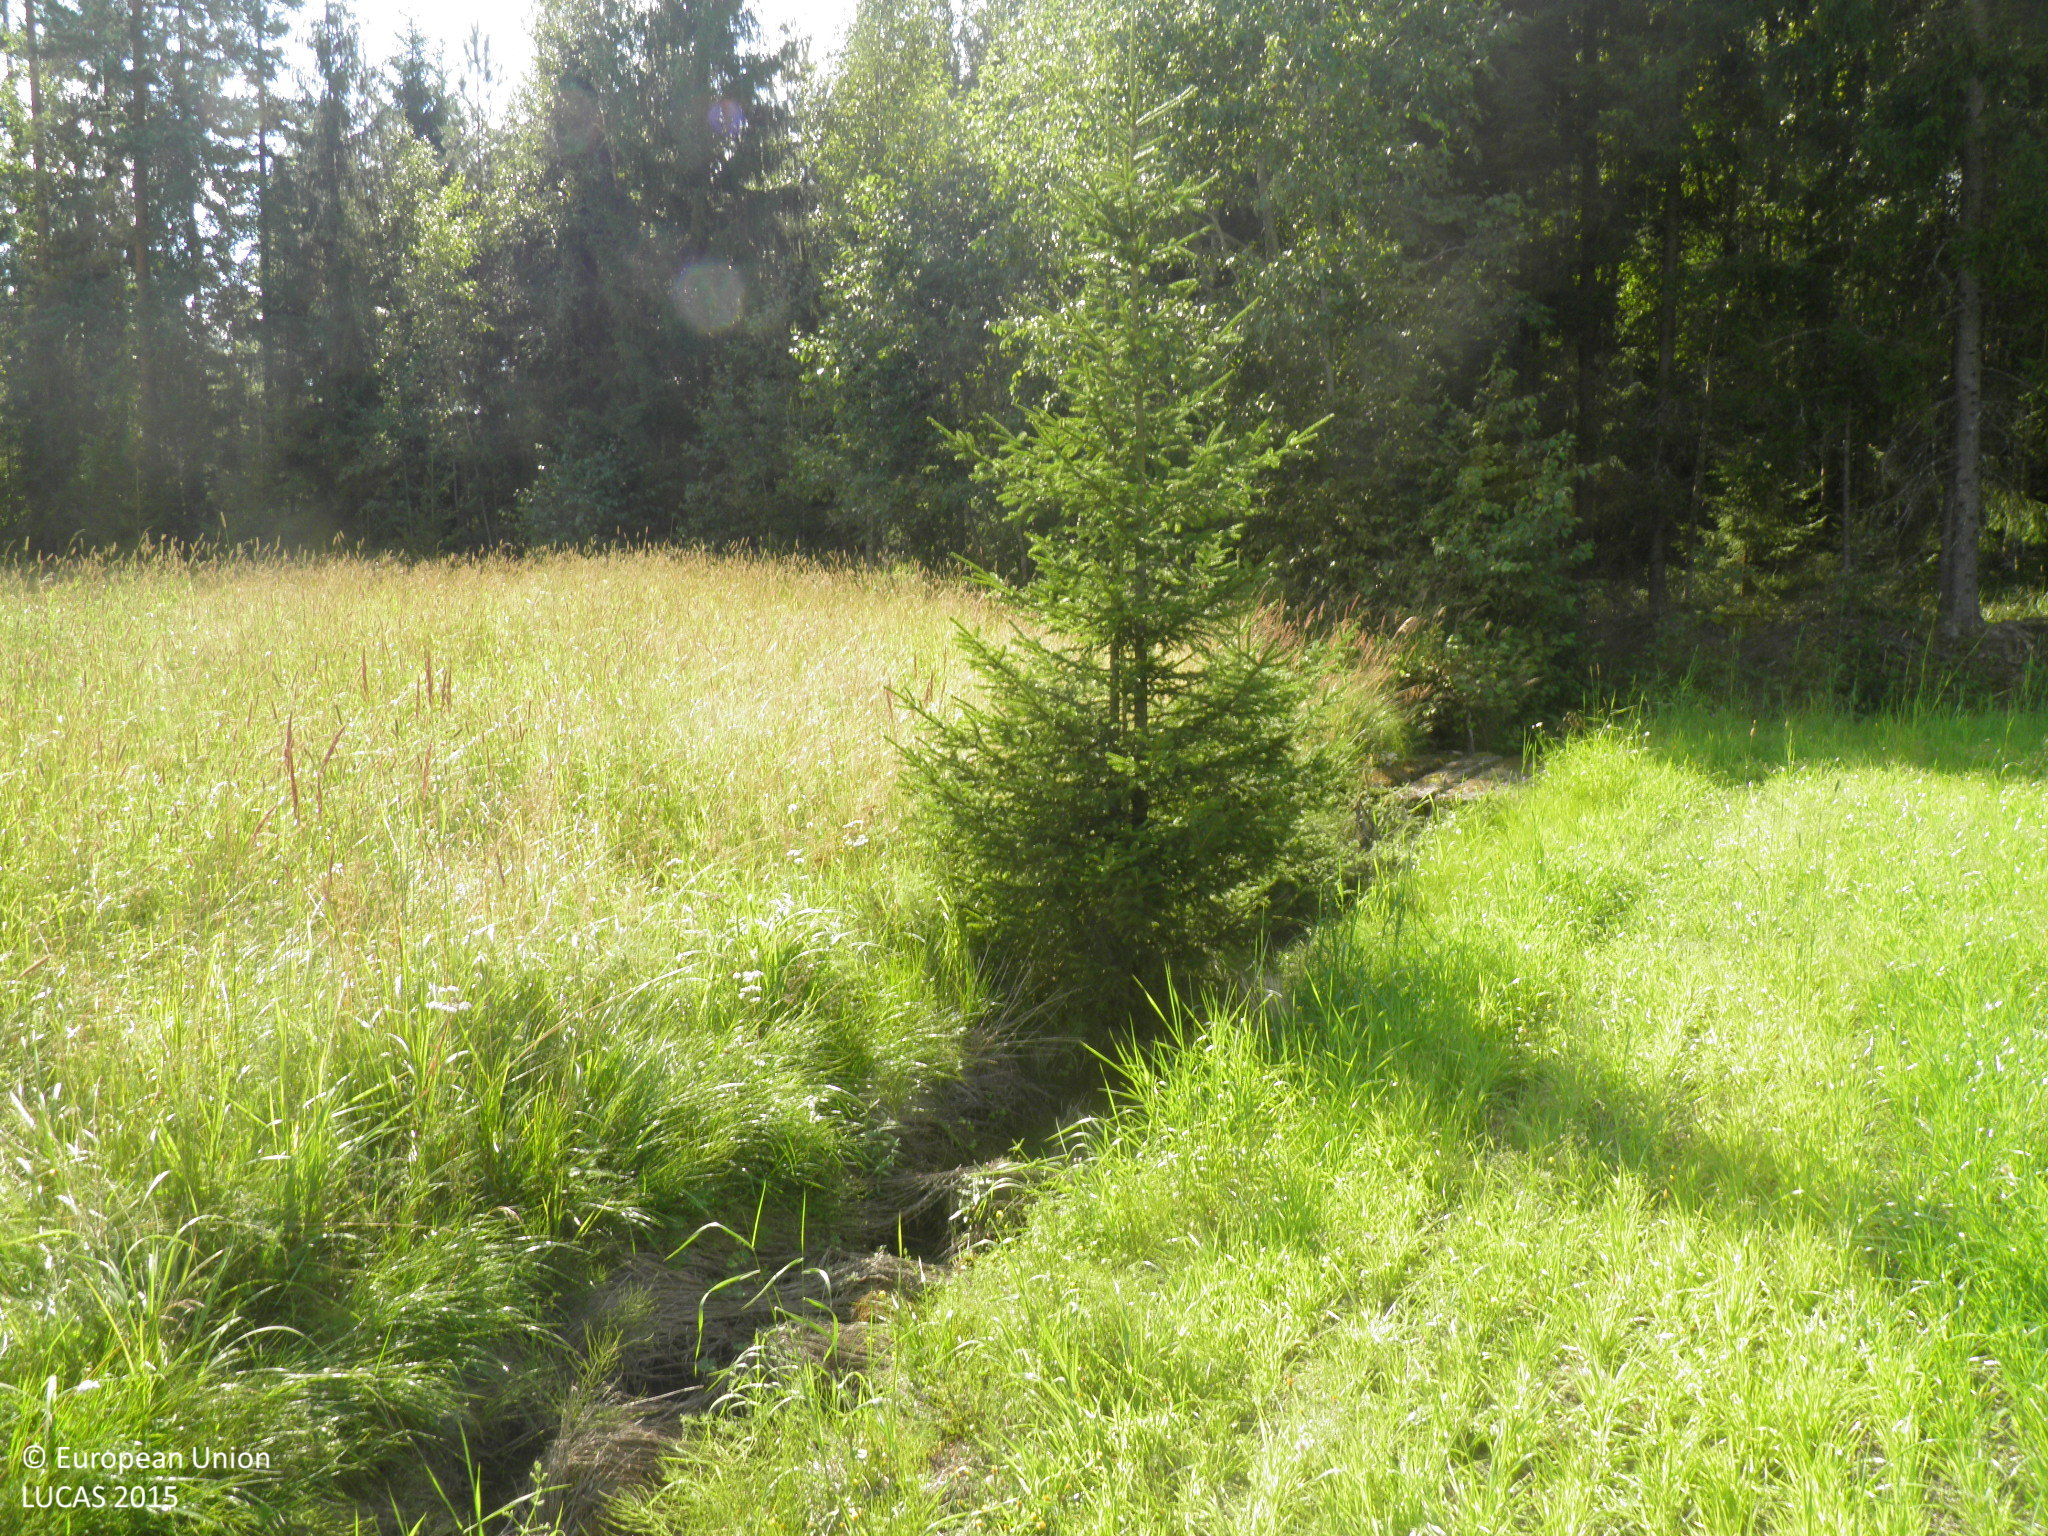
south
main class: Grassland
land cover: Grassland without tree/shrub cover
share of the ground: > 75 %
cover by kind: herbaceous plants 100 %
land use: Agriculture (excluding fallow land and kitchen gardens)
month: August
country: FI
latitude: 60.9878
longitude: 22.9572
